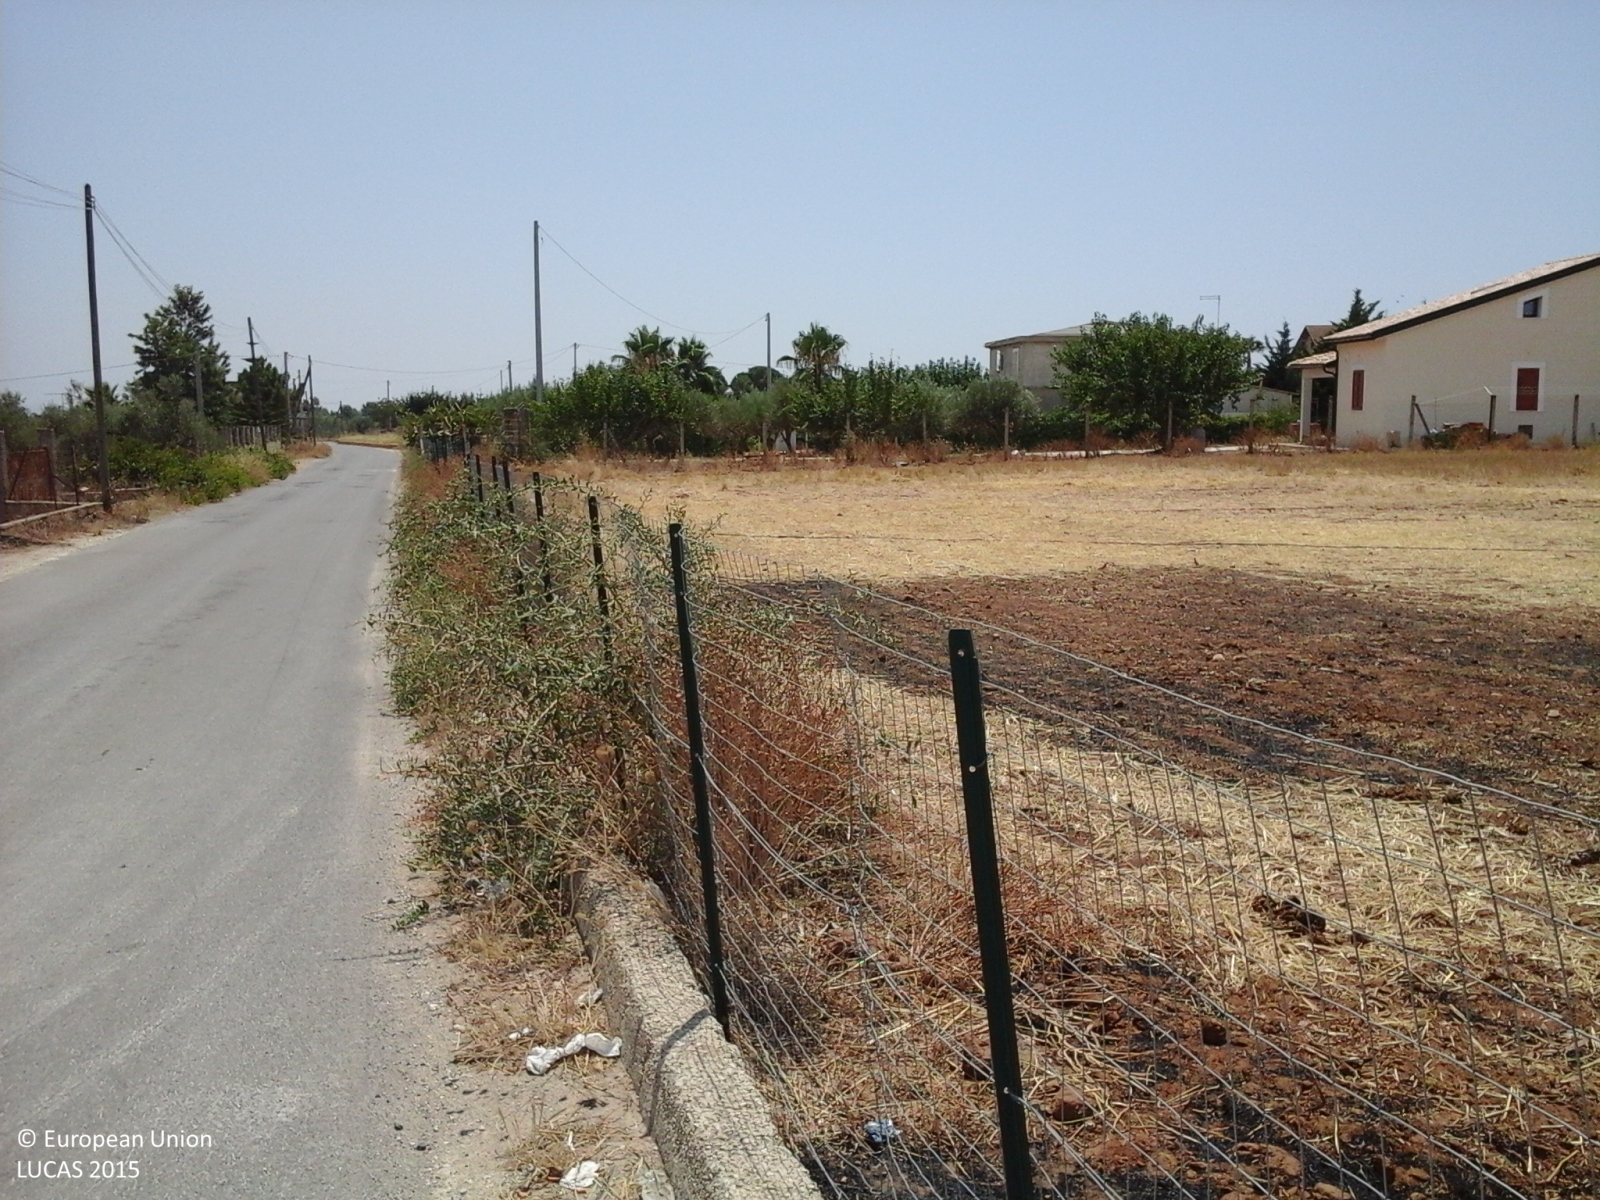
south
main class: Cropland
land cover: Durum wheat
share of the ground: > 75 %
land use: Agriculture (excluding fallow land and kitchen gardens)
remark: Burnt area
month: July
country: IT
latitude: 37.1541
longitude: 14.4133
